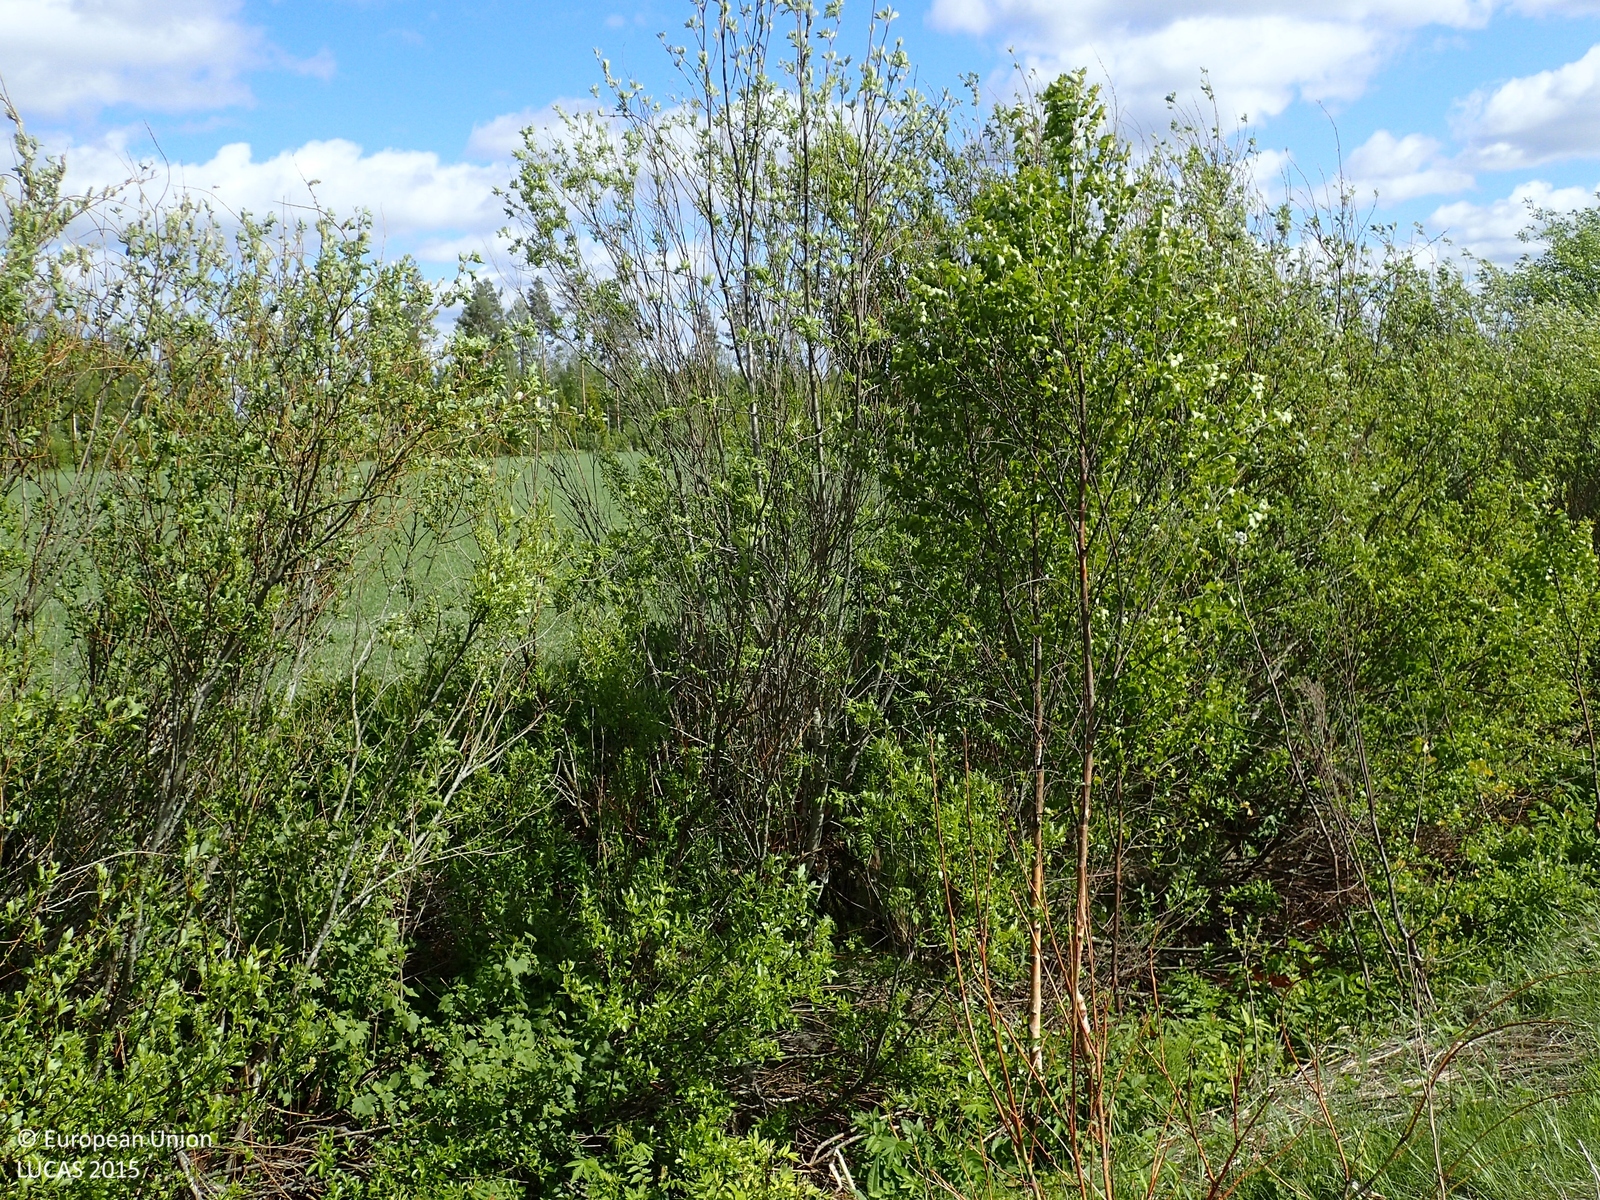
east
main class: Cropland
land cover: Oats
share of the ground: 25 - 50 %
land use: Agriculture (excluding fallow land and kitchen gardens)
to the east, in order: Oats; Shruby margins; Ditches and canals; Abandoned hedges; Common wheat; Ditches and canals; Abandoned hedges; Ditches and canals; Abandoned hedges; Spruce dominated mixed woodland
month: June
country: FI
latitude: 62.1926
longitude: 22.9973
